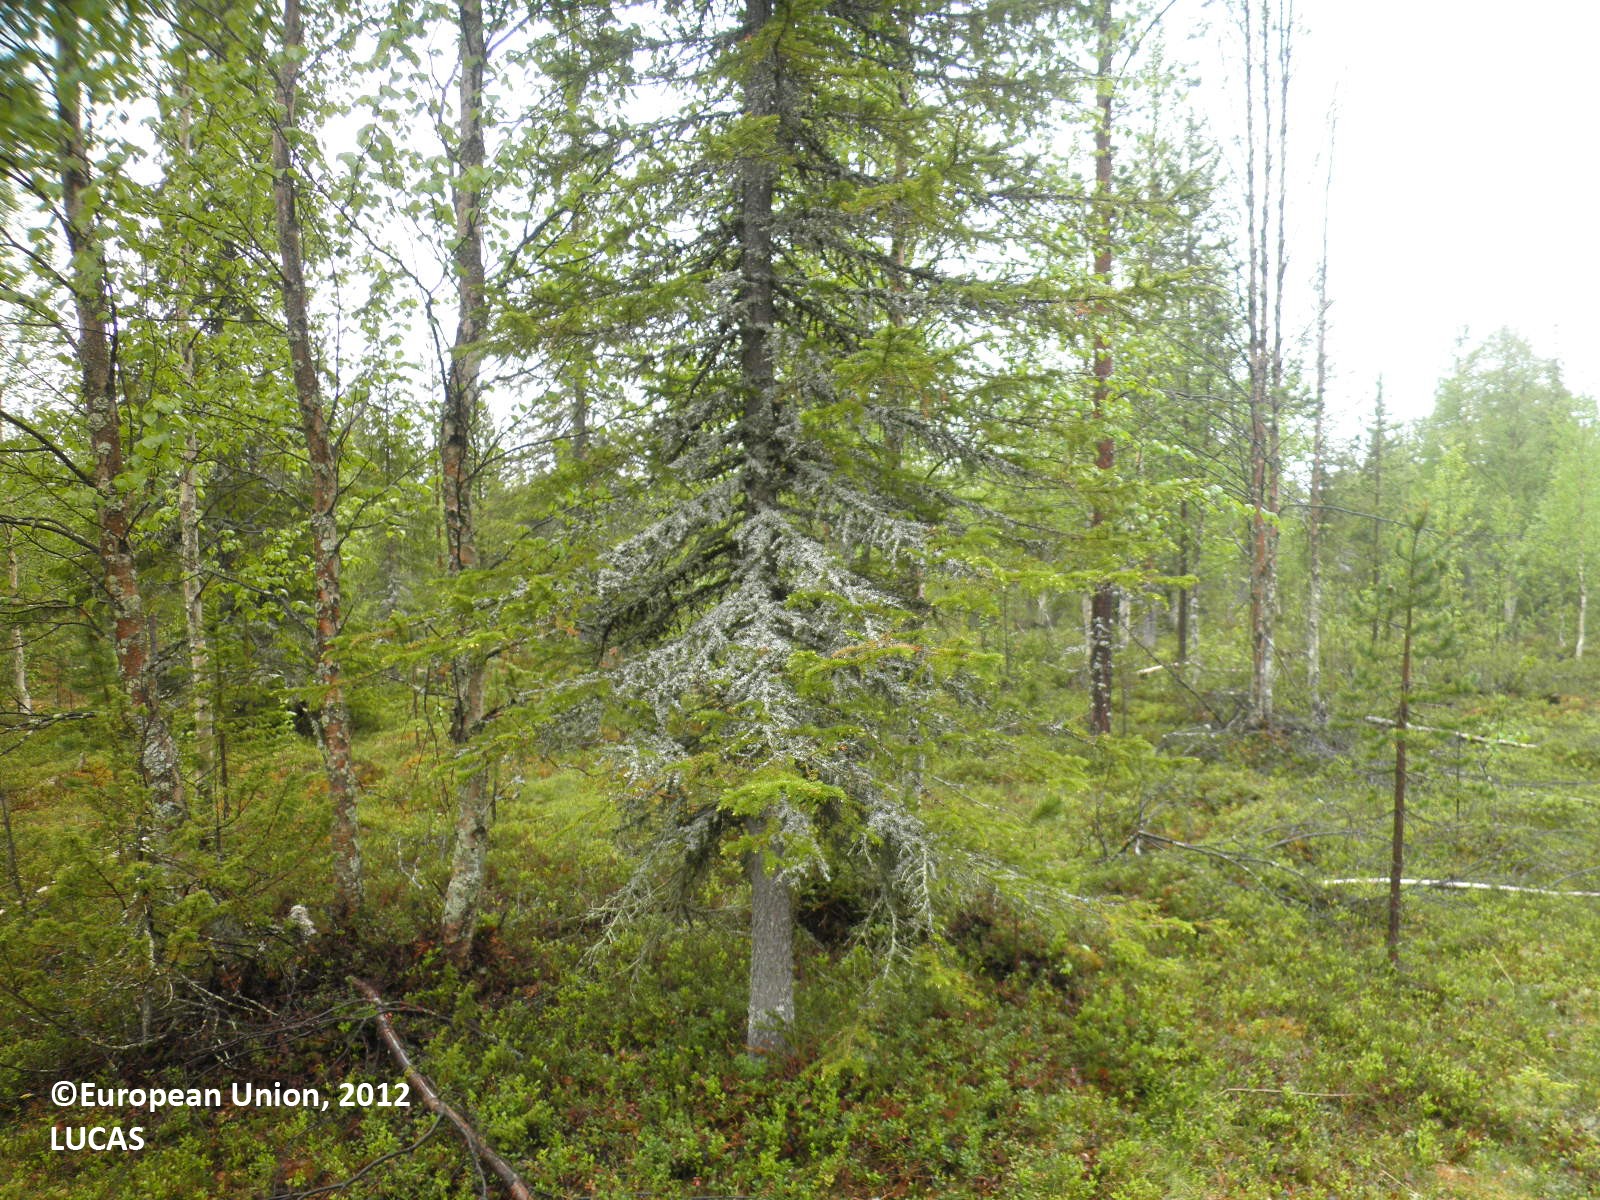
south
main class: Woodland
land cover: Spruce dominated mixed woodland
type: boreal forest
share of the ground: 50 - 75 %
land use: Forestry
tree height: > 5 m
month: June
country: FI
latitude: 67.9718
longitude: 25.6459
